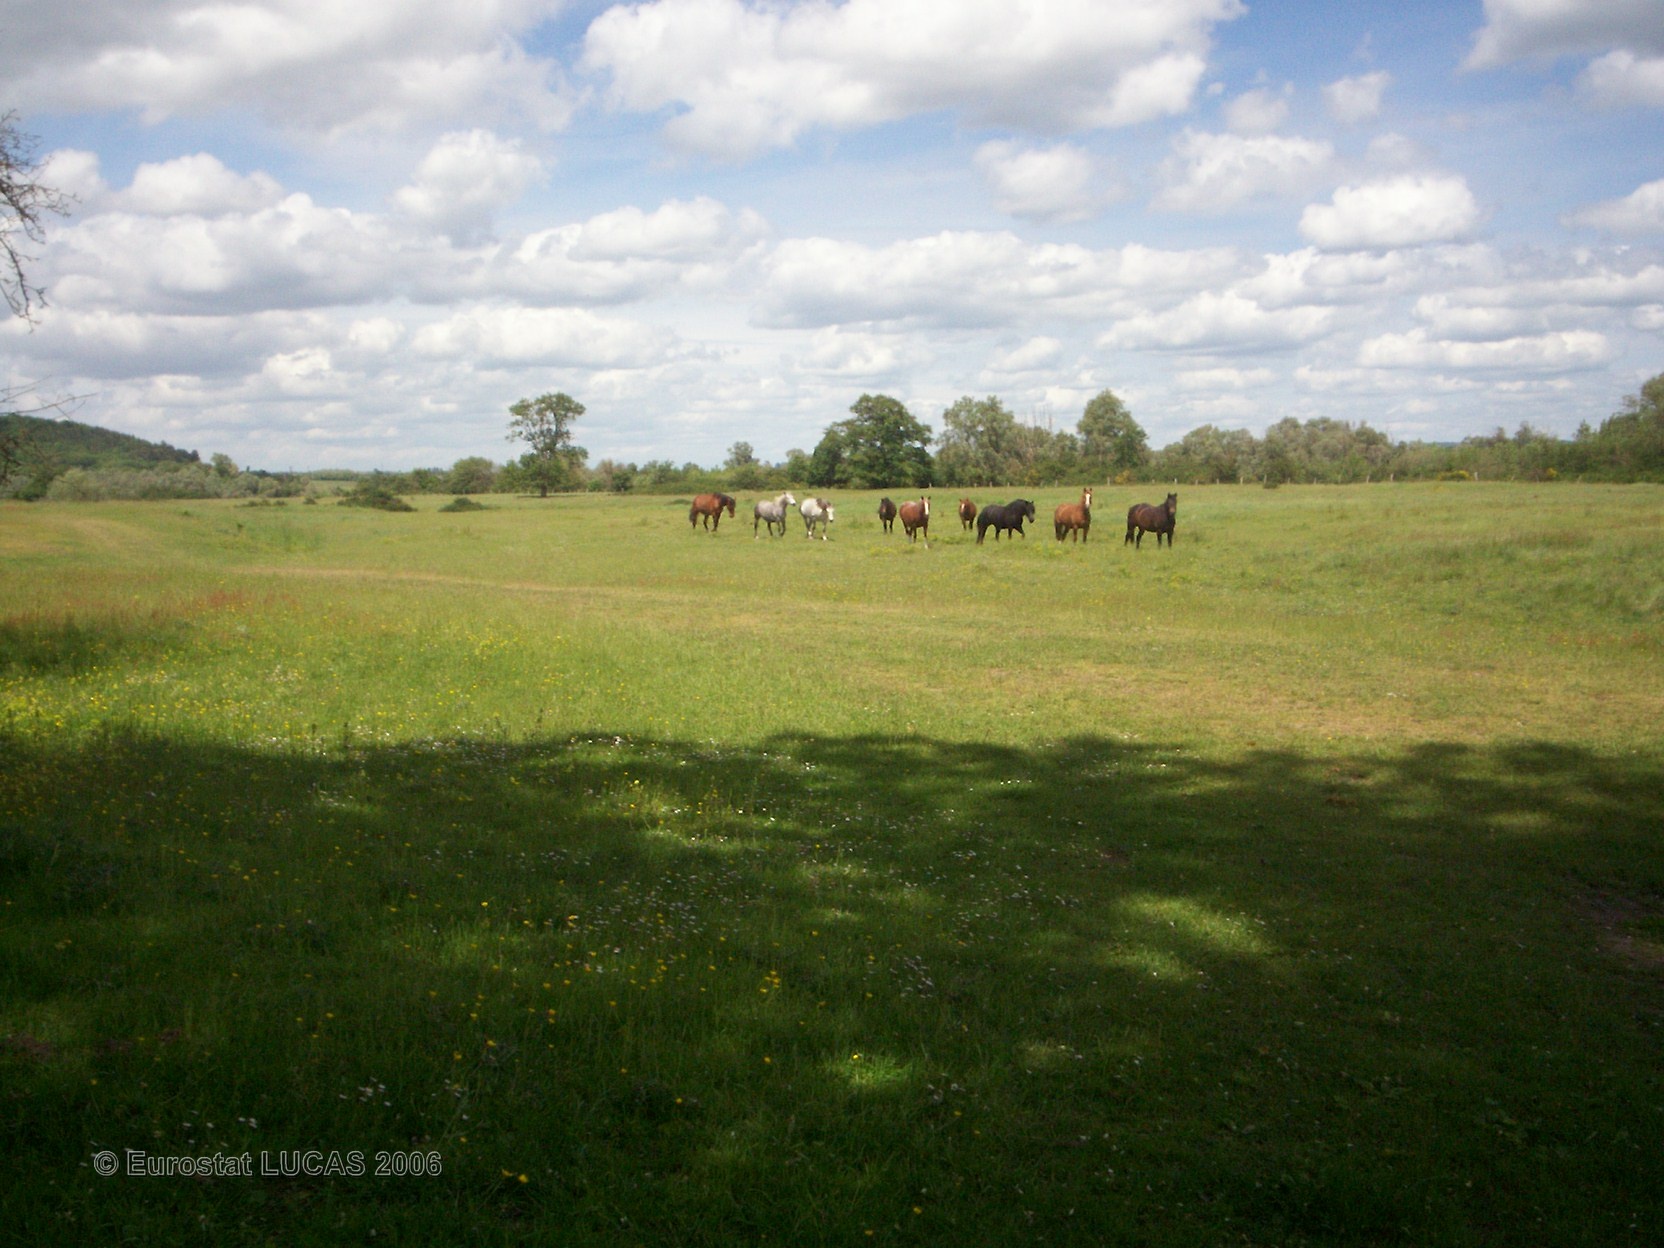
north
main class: Grassland
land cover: Grassland without tree/shrub cover
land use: Agriculture (excluding fallow land and kitchen gardens)
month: May
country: FR
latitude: 47.0473
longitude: 3.0590
